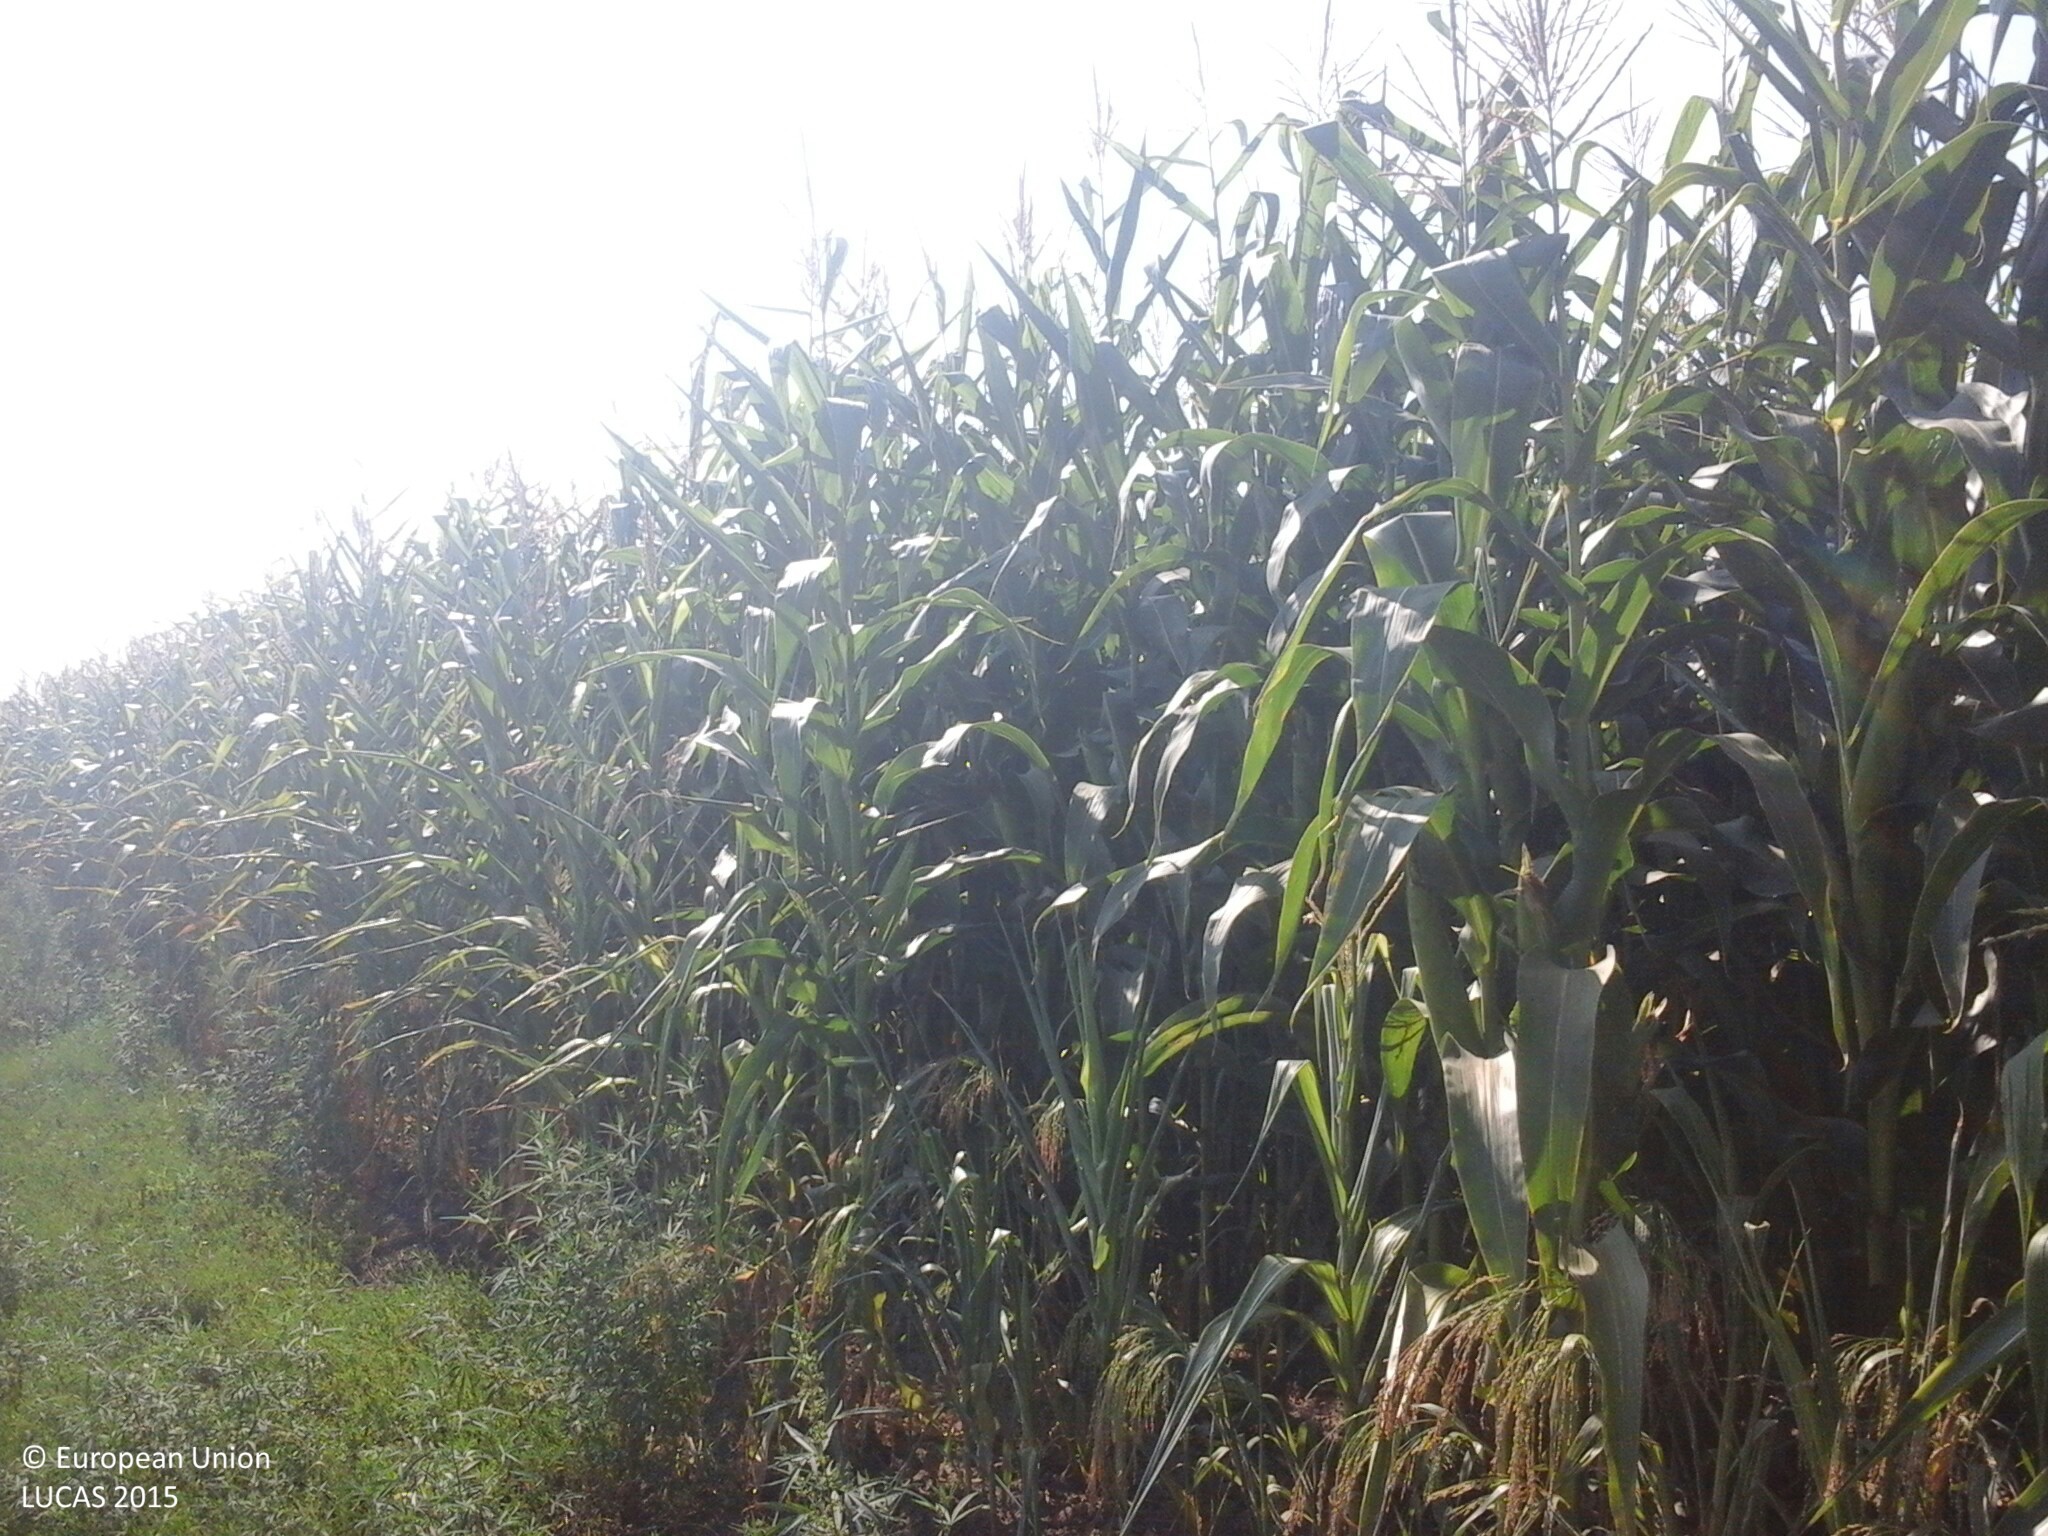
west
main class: Cropland
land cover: Maize
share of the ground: > 75 %
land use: Agriculture (excluding fallow land and kitchen gardens)
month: August
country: HU
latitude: 46.7919
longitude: 18.4873
